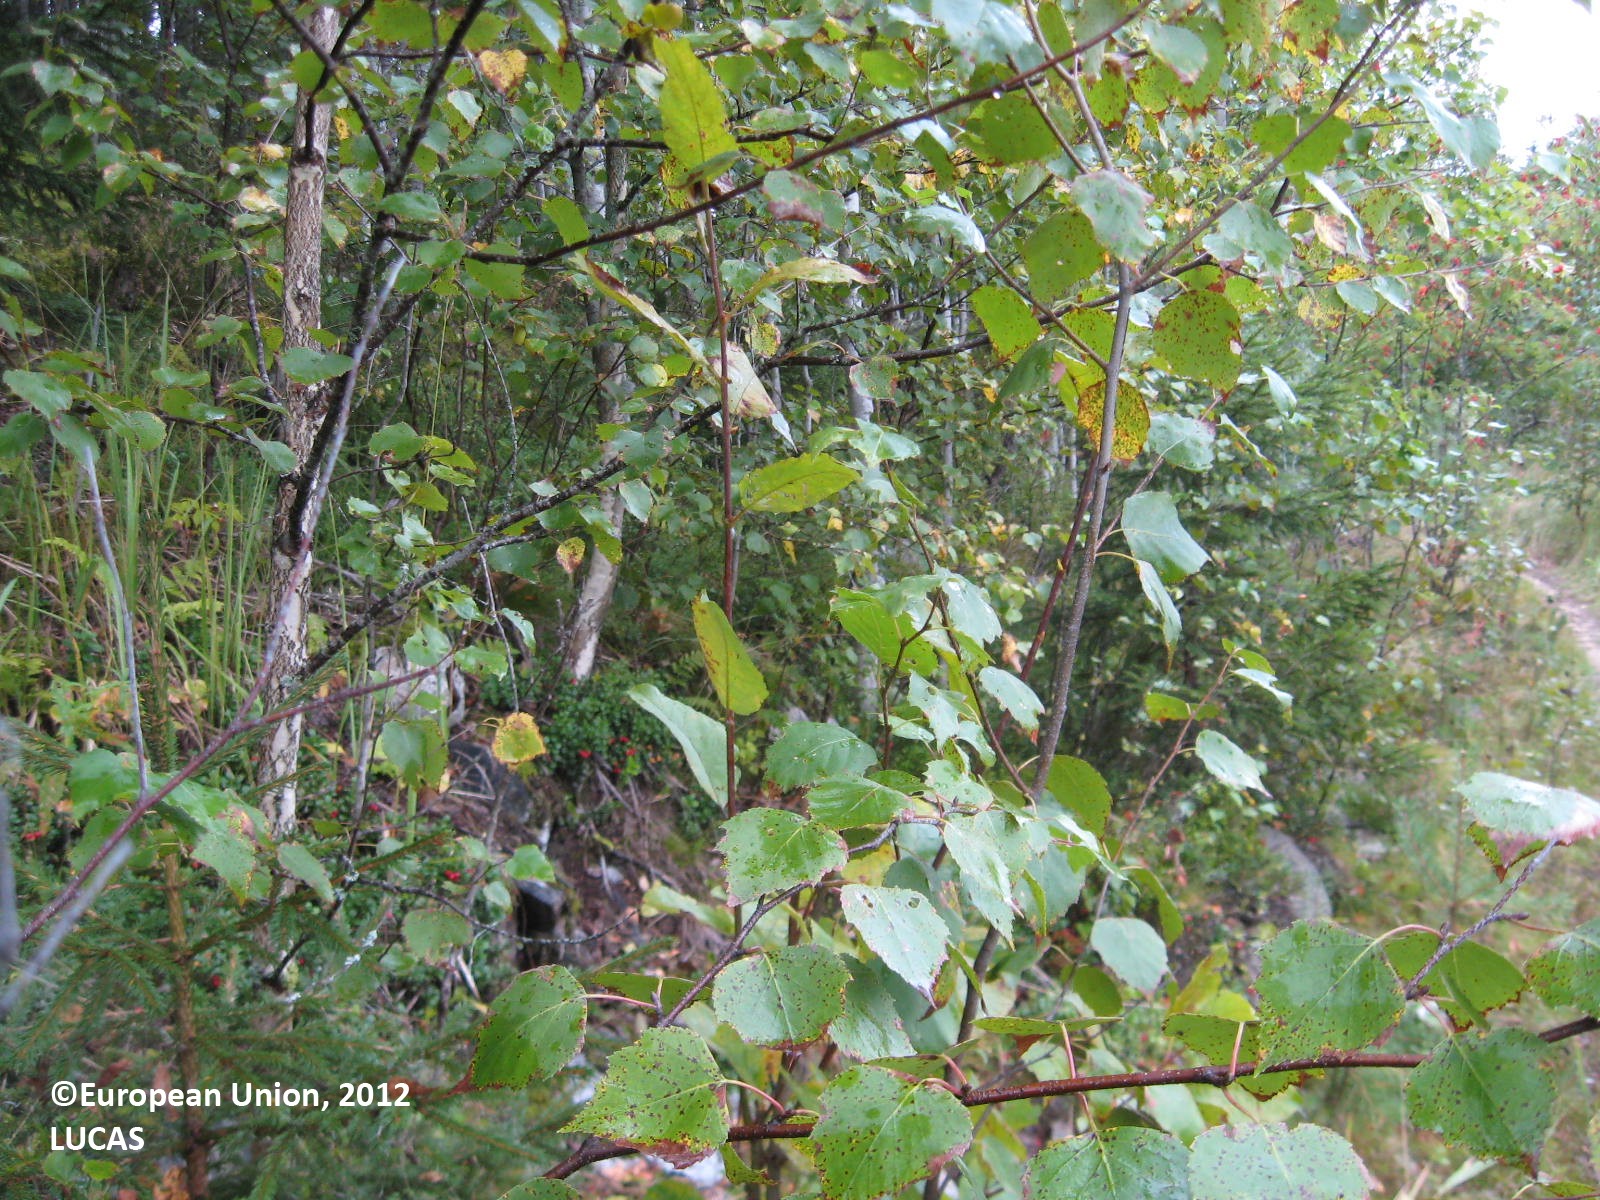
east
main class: Woodland
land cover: Broadleaved woodland
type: boreal forest
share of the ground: 50 - 75 %
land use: Forestry
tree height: > 5 m
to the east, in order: Broadleaved woodland; Tracks; Broadleaved woodland; Tracks; Other mixed woodland; Ditches and canals; Grass margins; Tracks; Grass margins; Ditches and canals; Spruce dominated coniferous woodland; Shruby margins; Pine dominated coniferous woodland
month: August
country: FI
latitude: 63.4928
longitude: 29.7373
